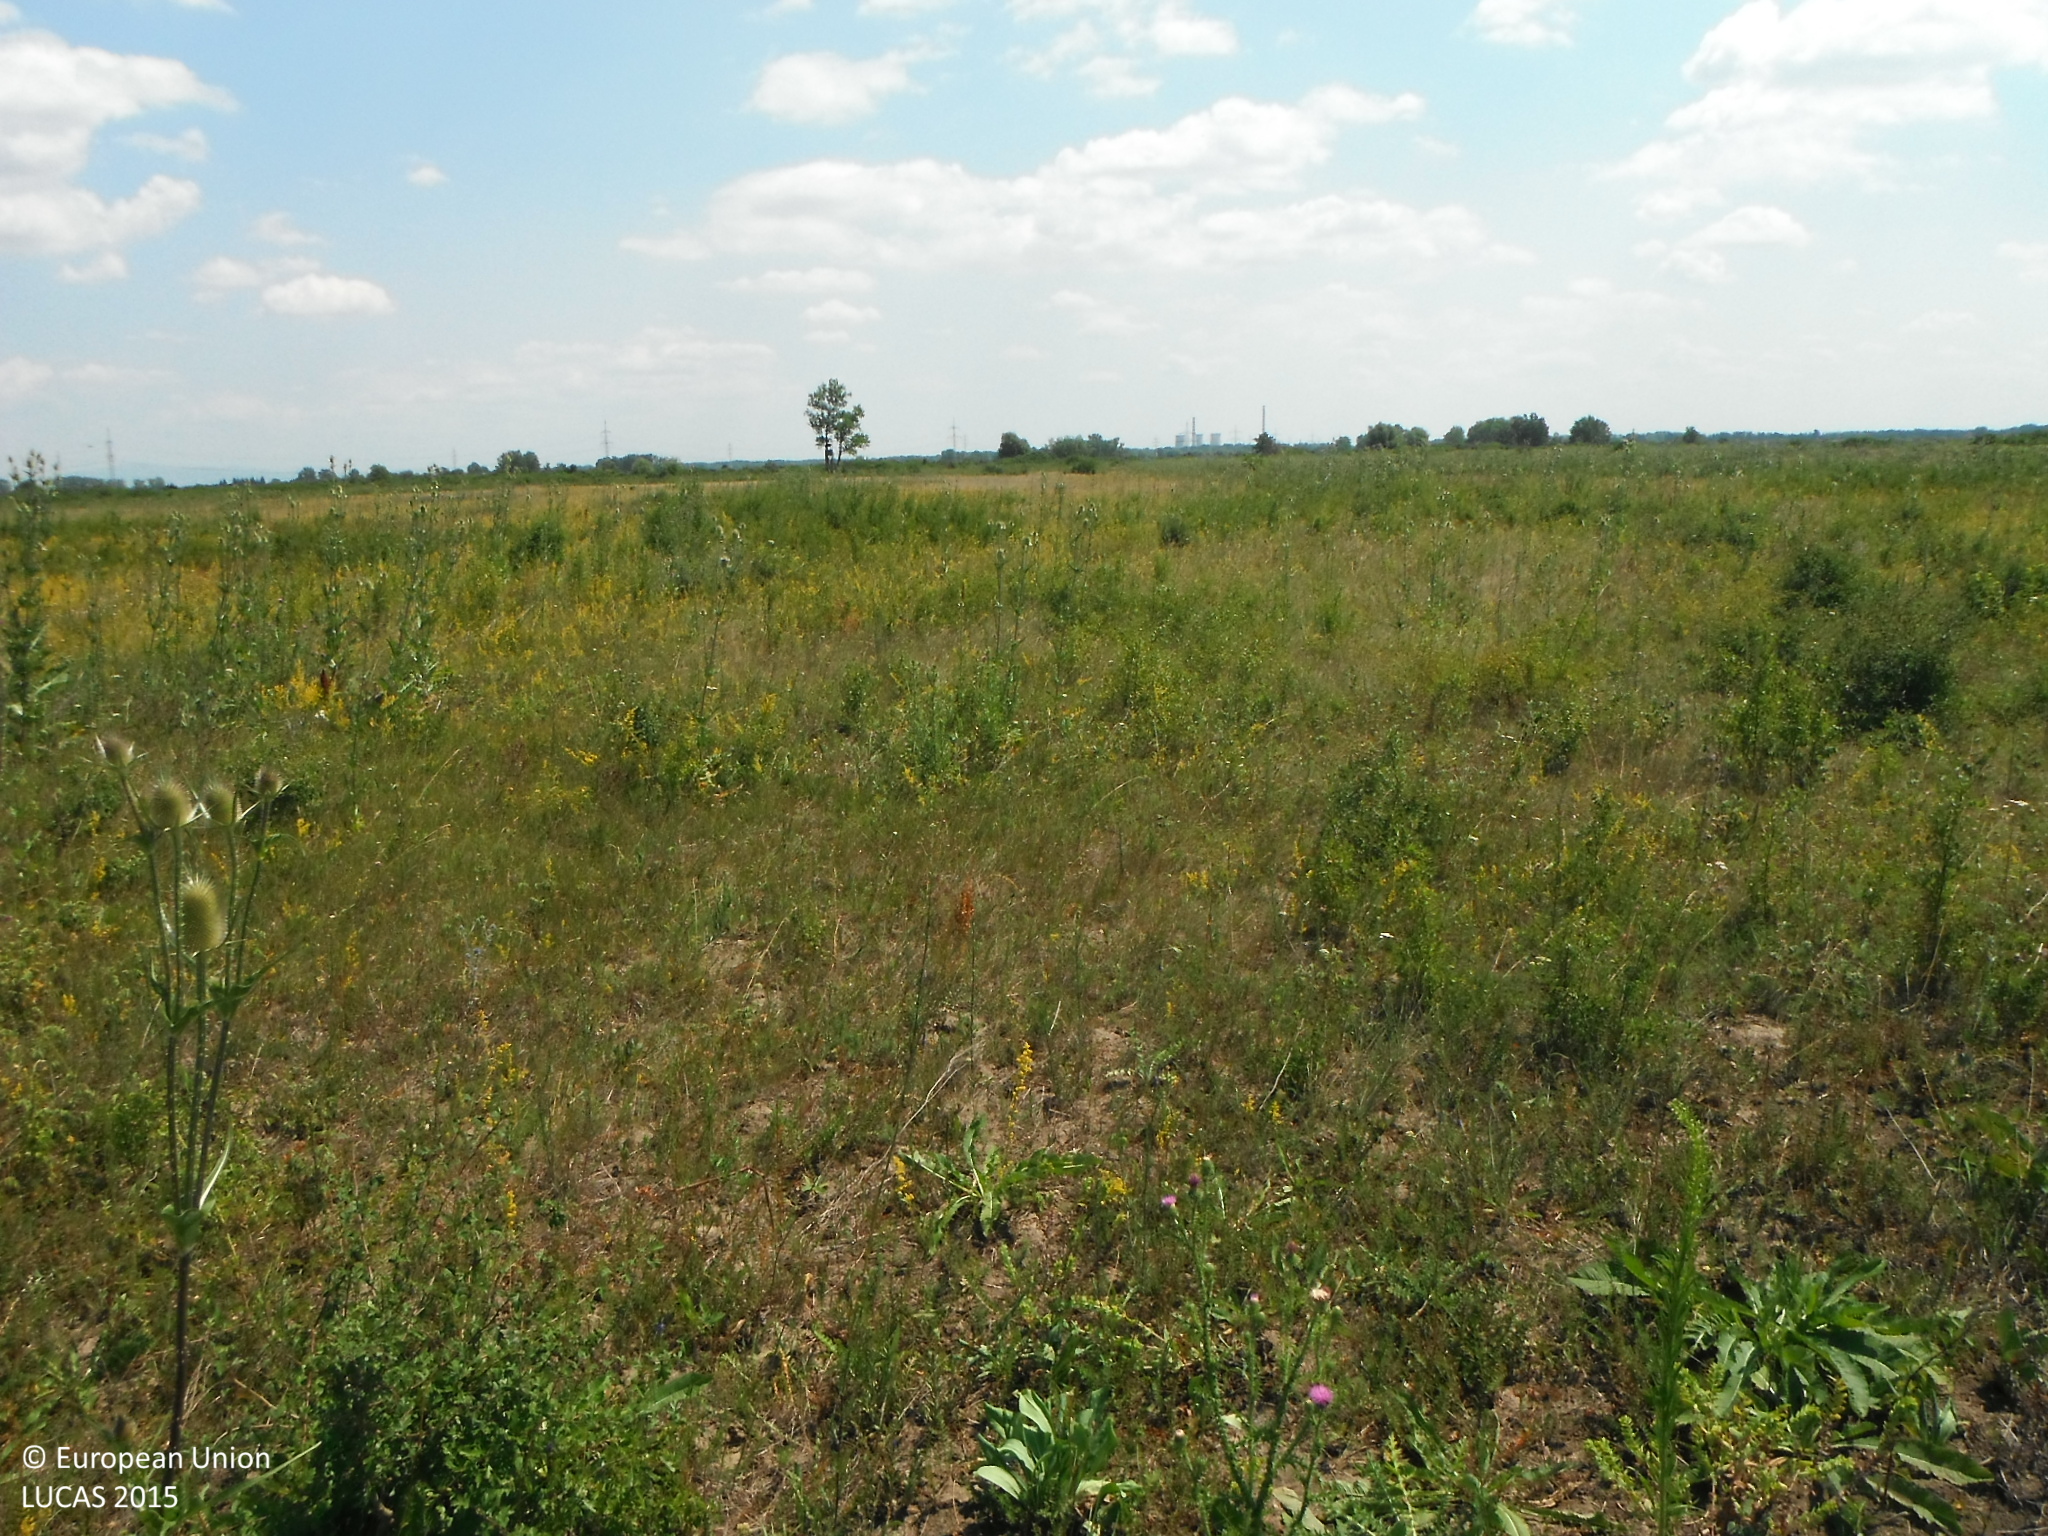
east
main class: Grassland
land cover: Spontaneously vegetated surfaces
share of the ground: > 75 %
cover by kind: herbaceous plants 100 %
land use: Agriculture (excluding fallow land and kitchen gardens)
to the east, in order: Spontaneously vegetated surfaces; Grassland without tree/shrub cover
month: July
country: SK
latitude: 48.5781
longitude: 21.8858
